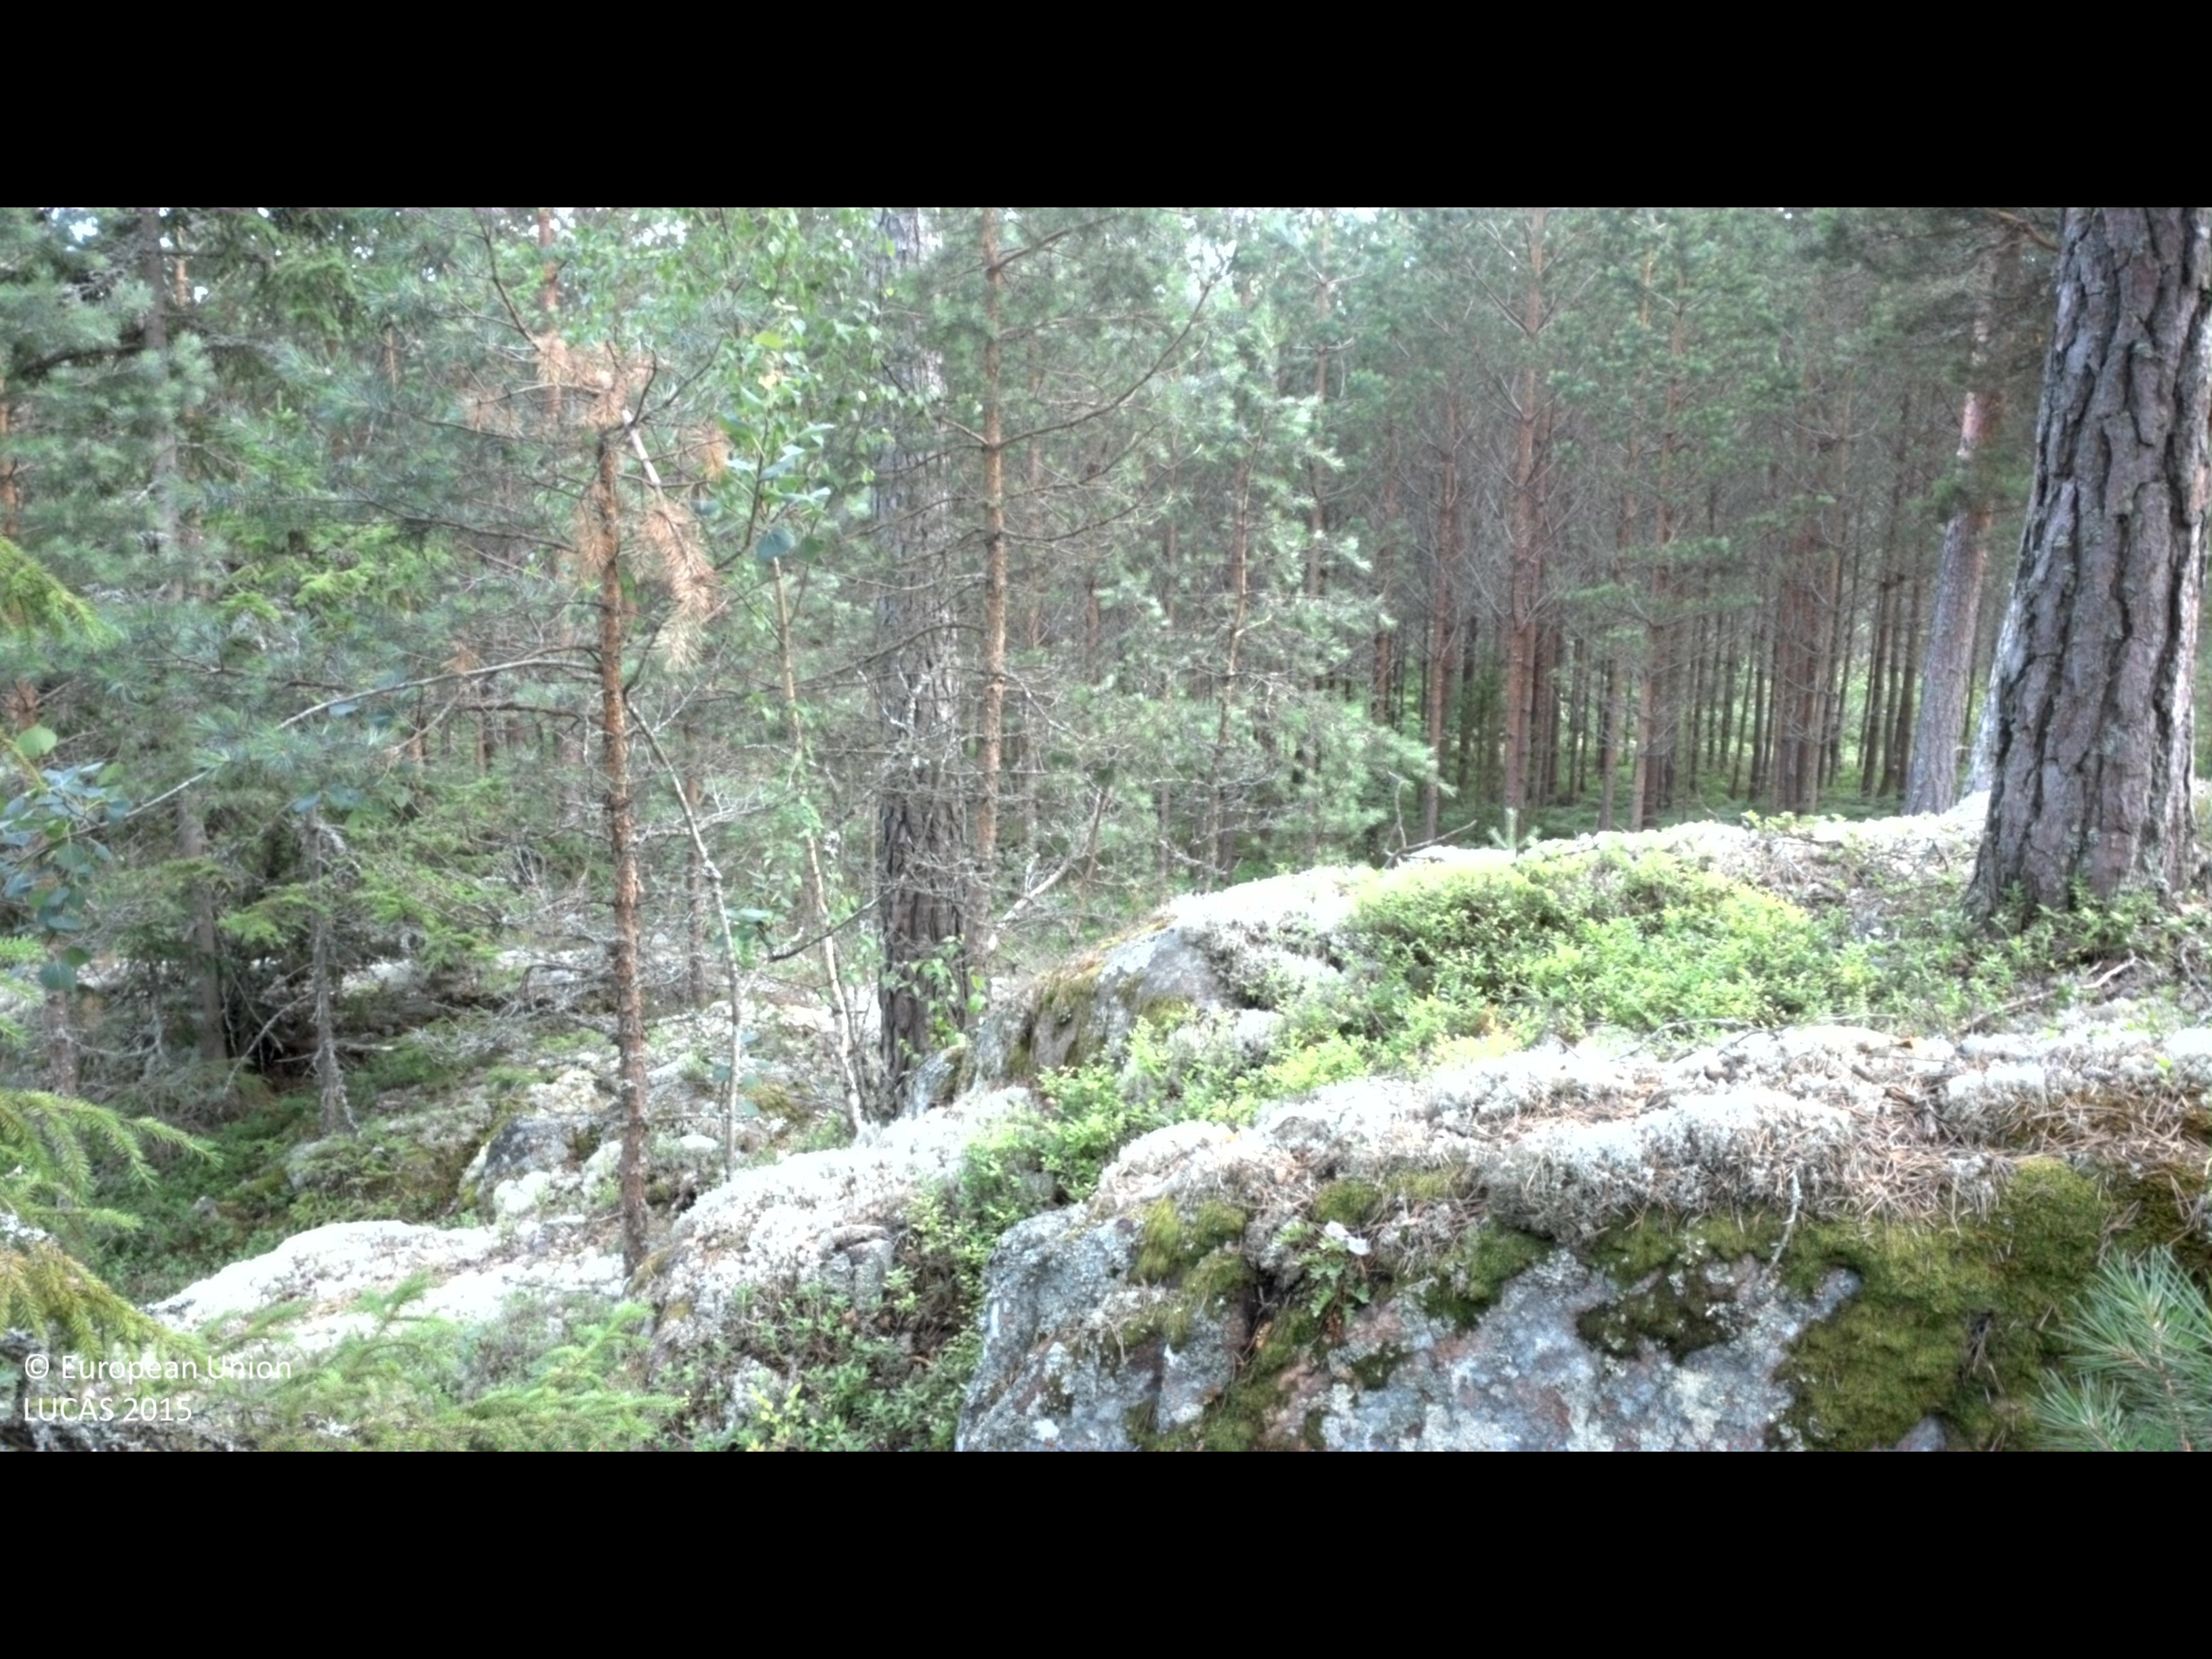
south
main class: Woodland
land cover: Pine dominated coniferous woodland
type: boreal forest
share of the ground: 50 - 75 %
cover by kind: coniferous forest trees 65 %, shrubs 20 %, lichens and mosses 15 %
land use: Forestry
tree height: > 5 m
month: July
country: SE
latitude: 58.4041
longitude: 16.1390
